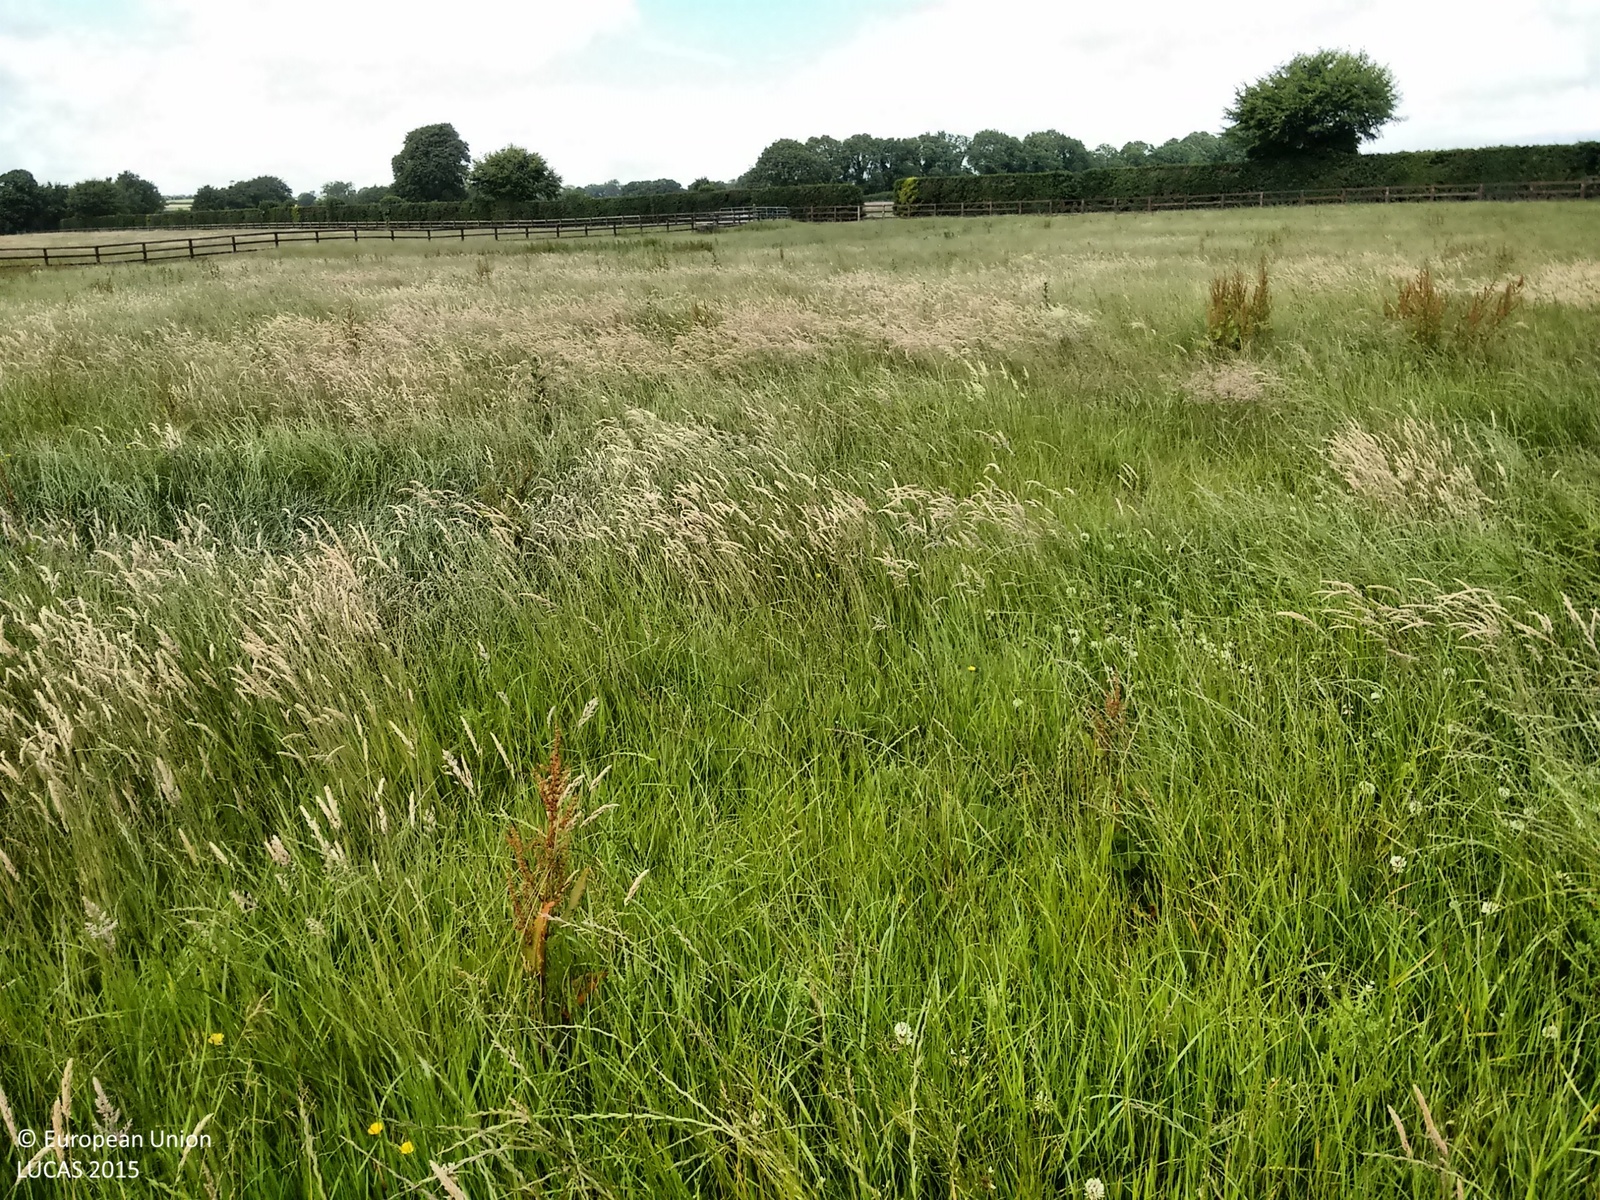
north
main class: Grassland
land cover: Grassland without tree/shrub cover
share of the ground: > 75 %
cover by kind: herbaceous plants 100 %
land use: Agriculture (excluding fallow land and kitchen gardens)
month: June
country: IE
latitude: 52.0999
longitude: -8.1824
